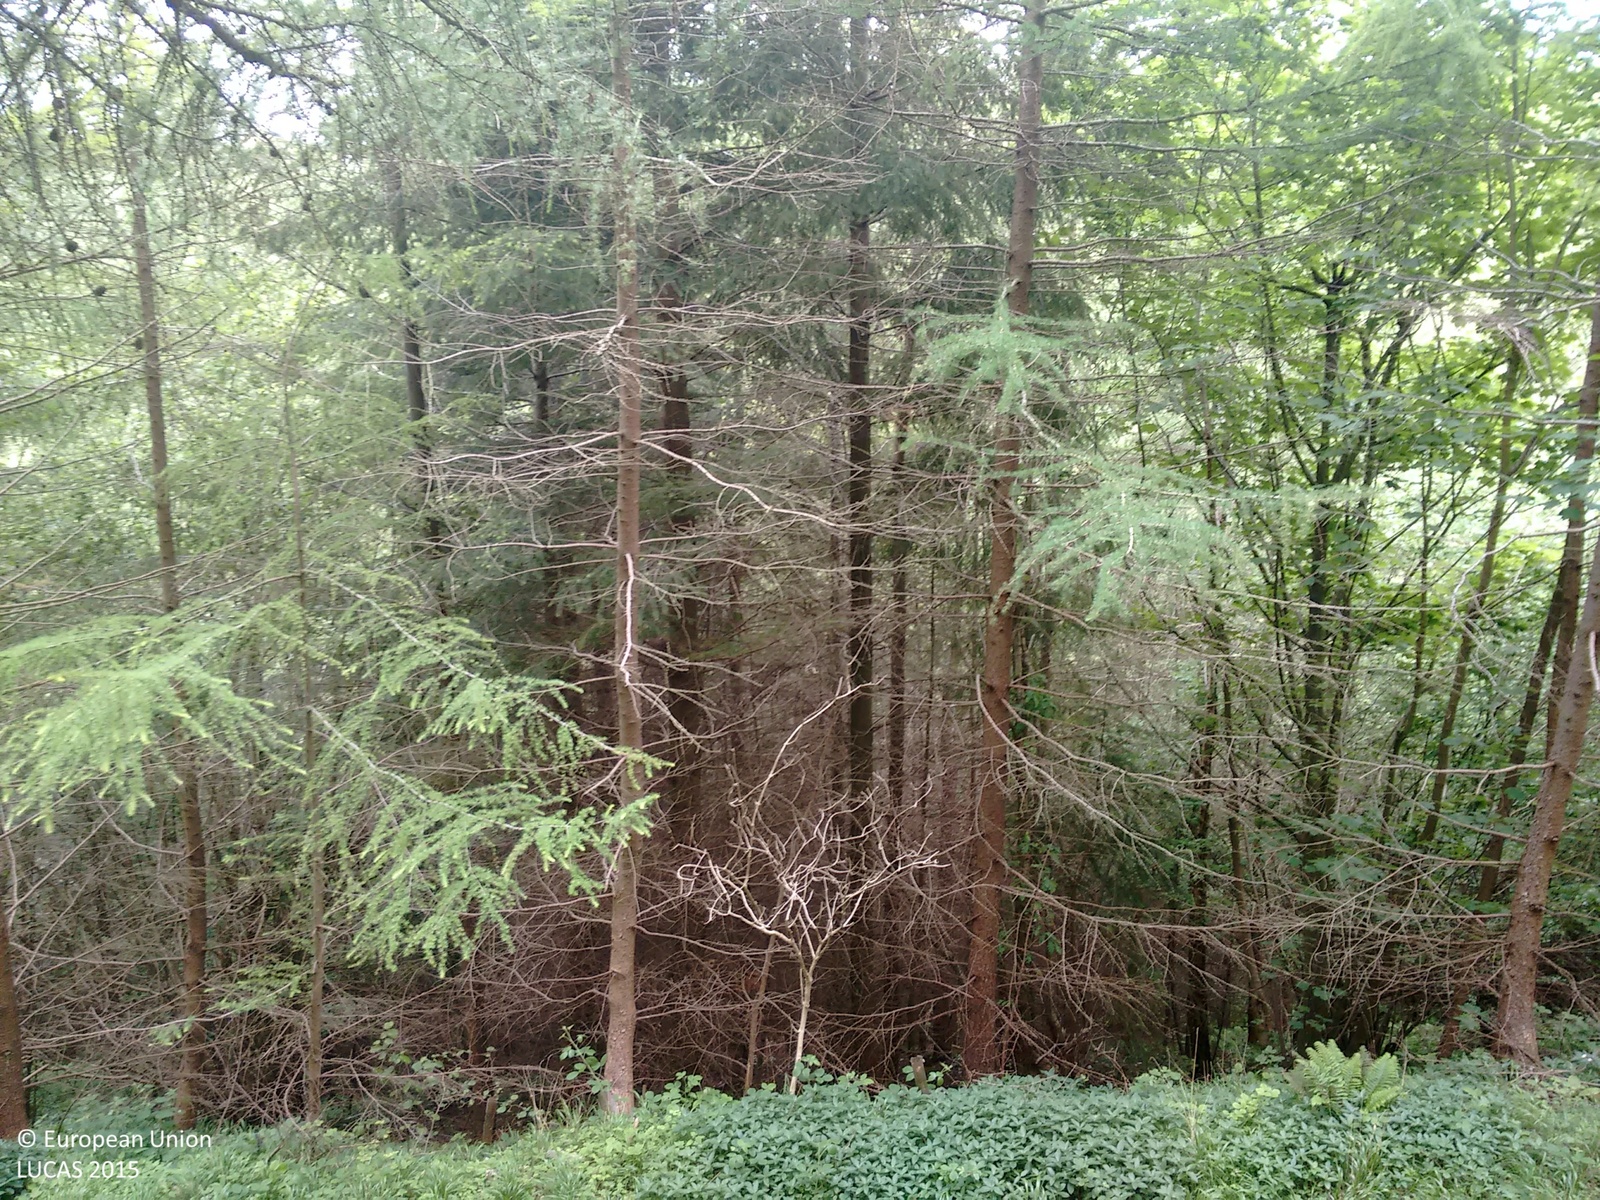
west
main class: Woodland
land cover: Pine dominated mixed woodland
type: exotic forest
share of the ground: > 75 %
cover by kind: coniferous forest trees 70 %, broadleaved forest trees 30 %
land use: Forestry
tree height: > 5 m
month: June
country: GB
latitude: 54.2712
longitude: -1.0840
